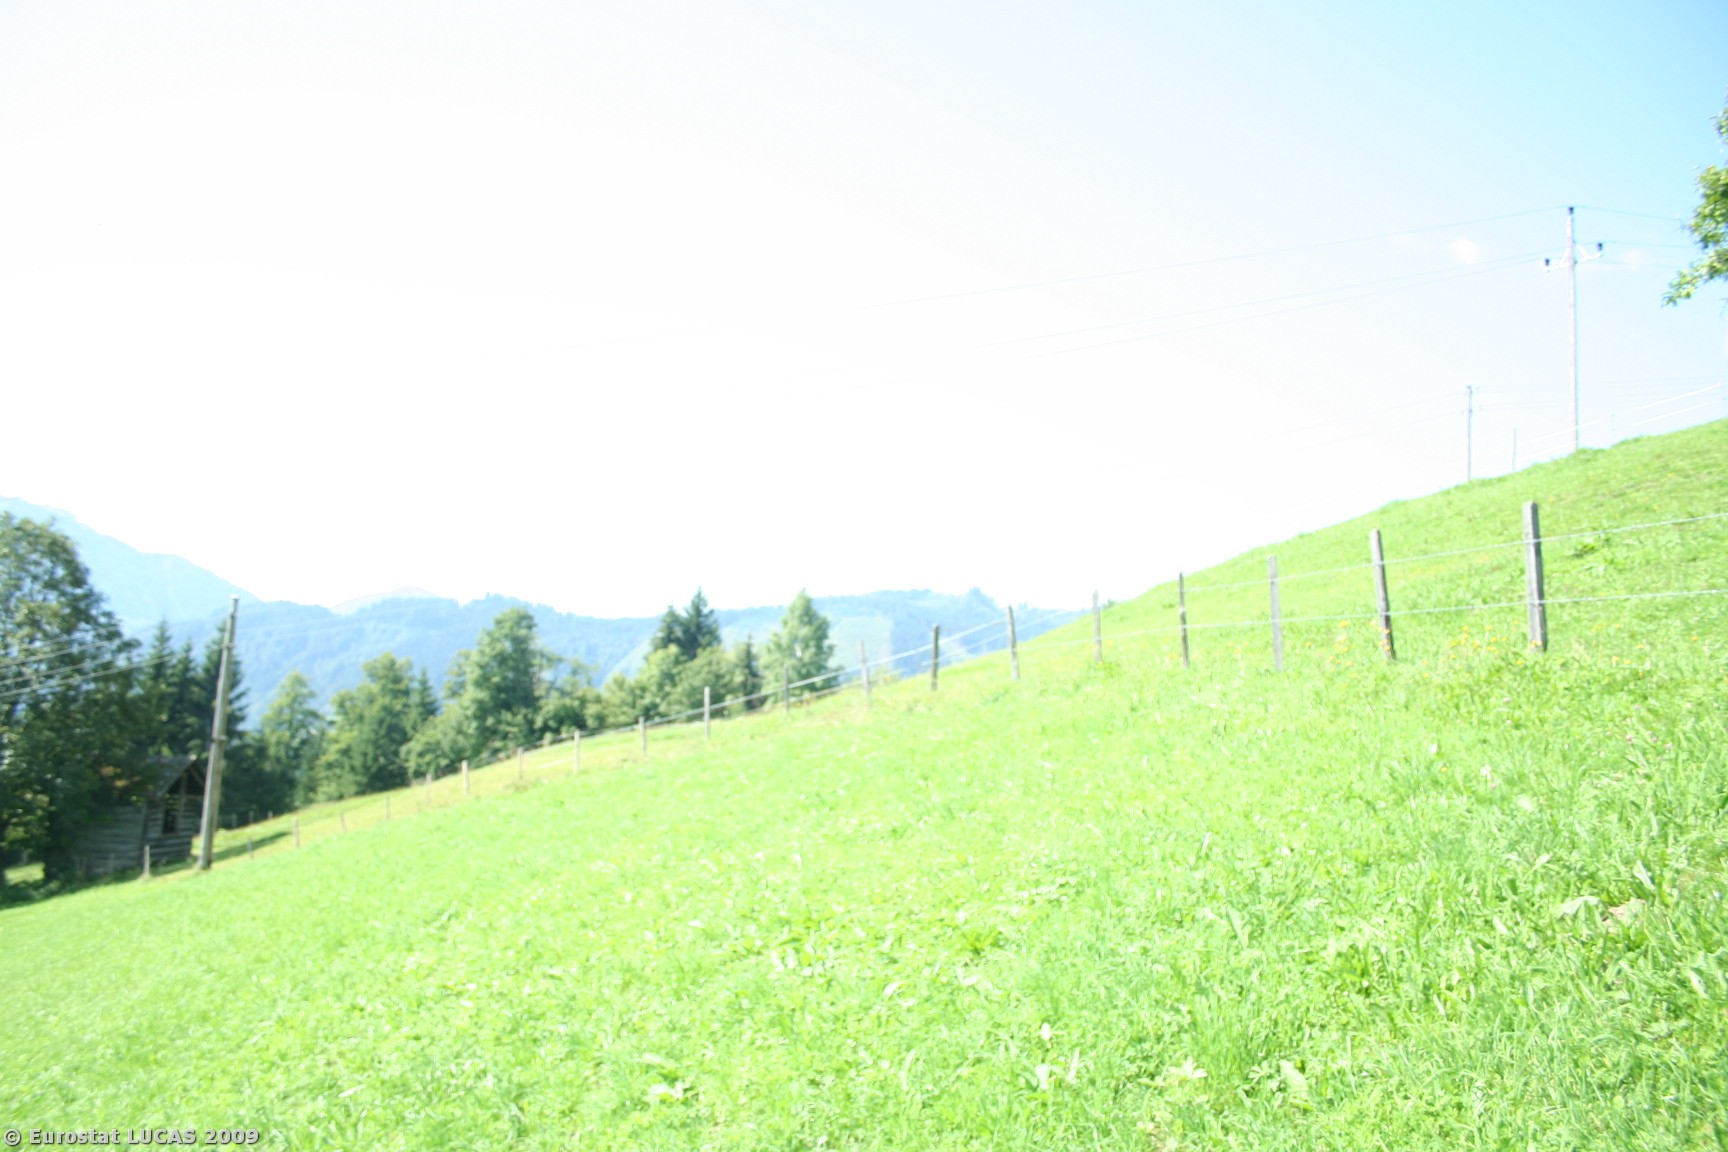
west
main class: Grassland
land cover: Grassland without tree/shrub cover
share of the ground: > 75 %
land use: Agriculture (excluding fallow land and kitchen gardens)
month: August
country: AT
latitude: 47.3669
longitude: 13.1894
